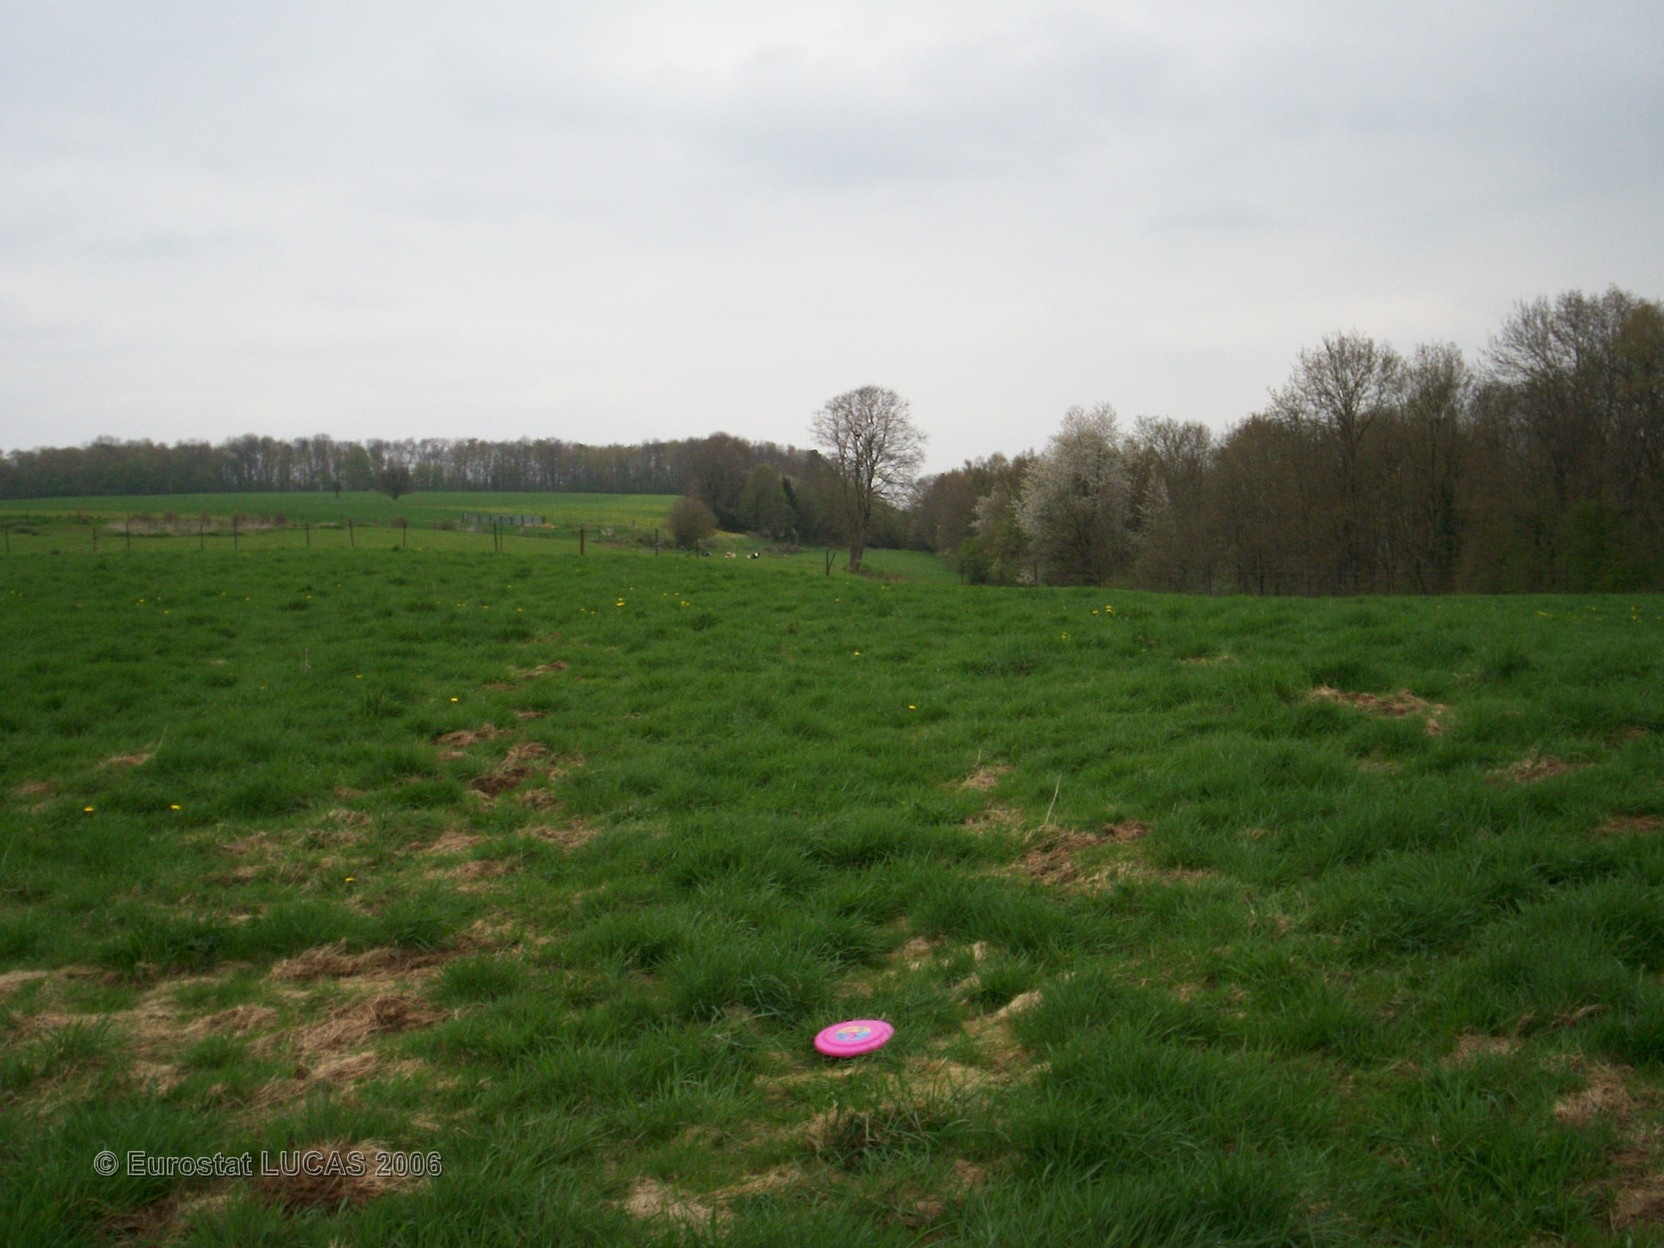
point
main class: Grassland
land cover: Grassland without tree/shrub cover
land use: Agriculture (excluding fallow land and kitchen gardens)
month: April
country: FR
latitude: 49.7471
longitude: 4.5421
